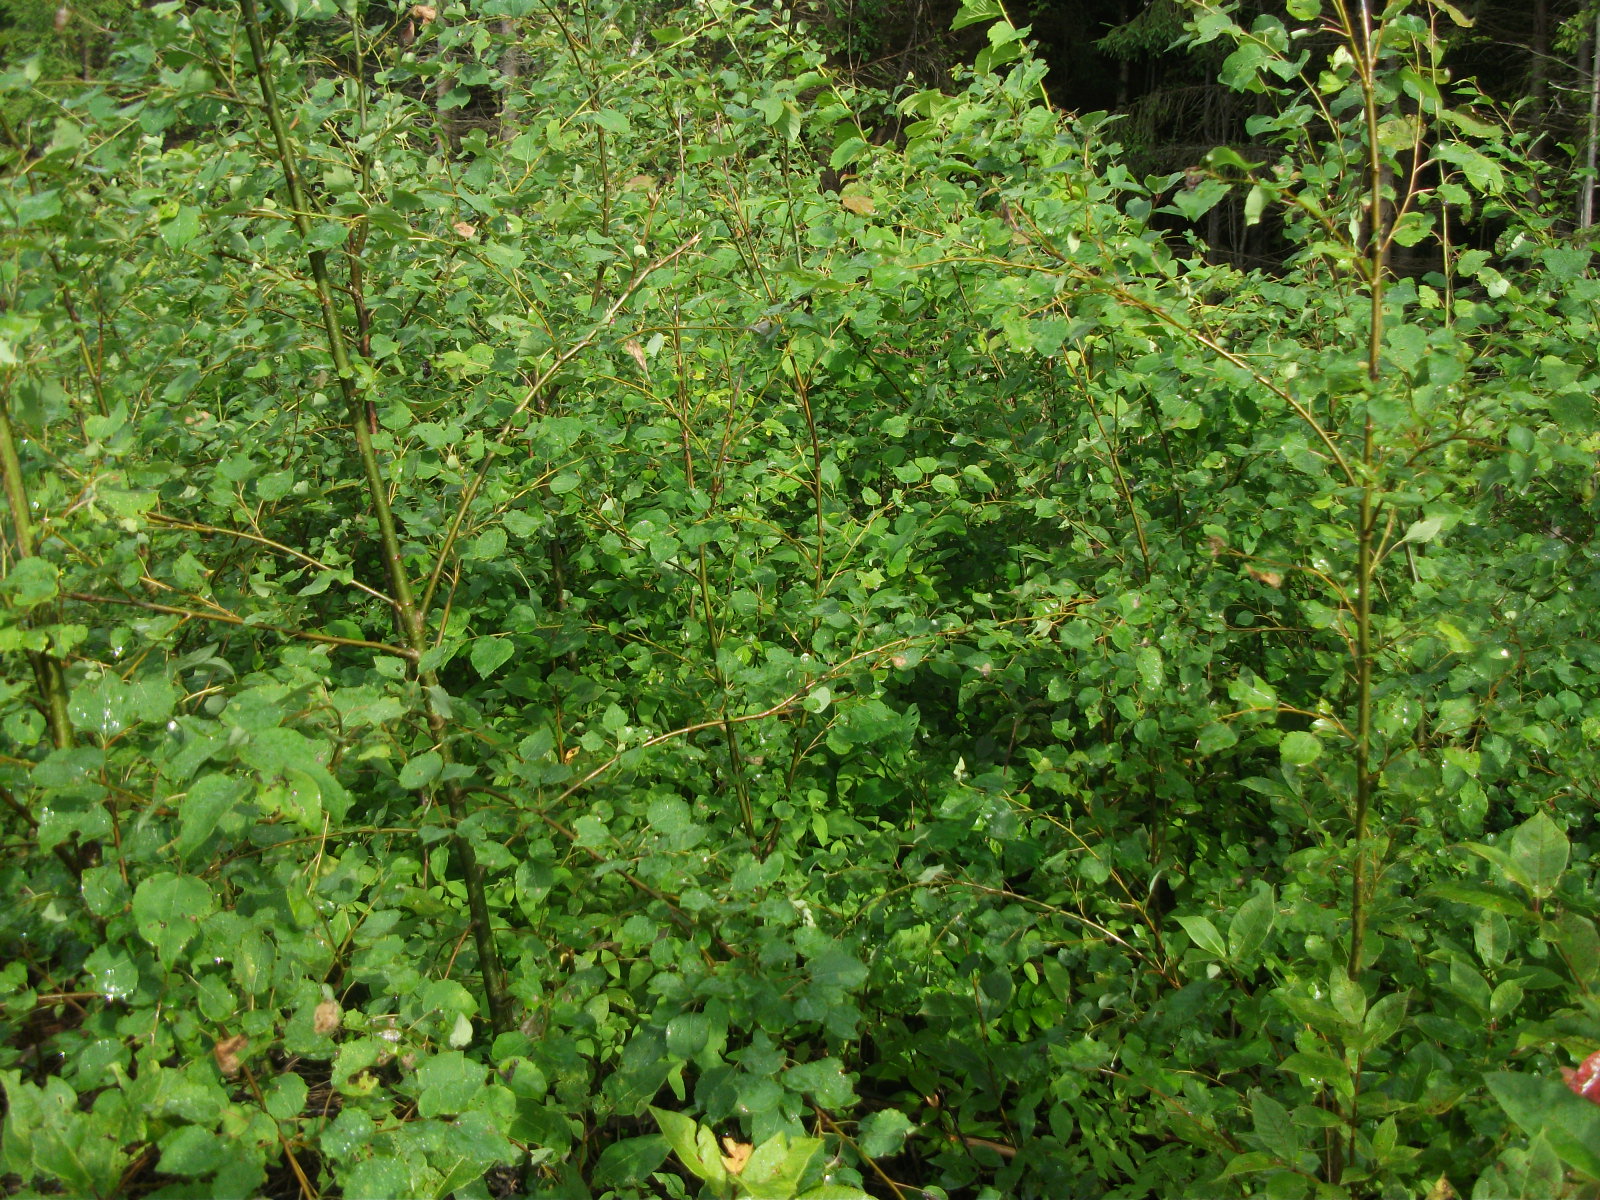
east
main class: Woodland
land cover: Broadleaved woodland
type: non-riverine alder, birch or aspen forest
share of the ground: > 75 %
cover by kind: broadleaved forest trees 90 %, shrubs 10 %
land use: Forestry
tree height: < 5 m
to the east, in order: Broadleaved woodland; Spruce dominated coniferous woodland; Broadleaved woodland; Grass margins; Tracks; Grass margins; Spruce dominated mixed woodland; Broadleaved woodland
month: July
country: LV
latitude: 57.0202
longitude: 26.2302
